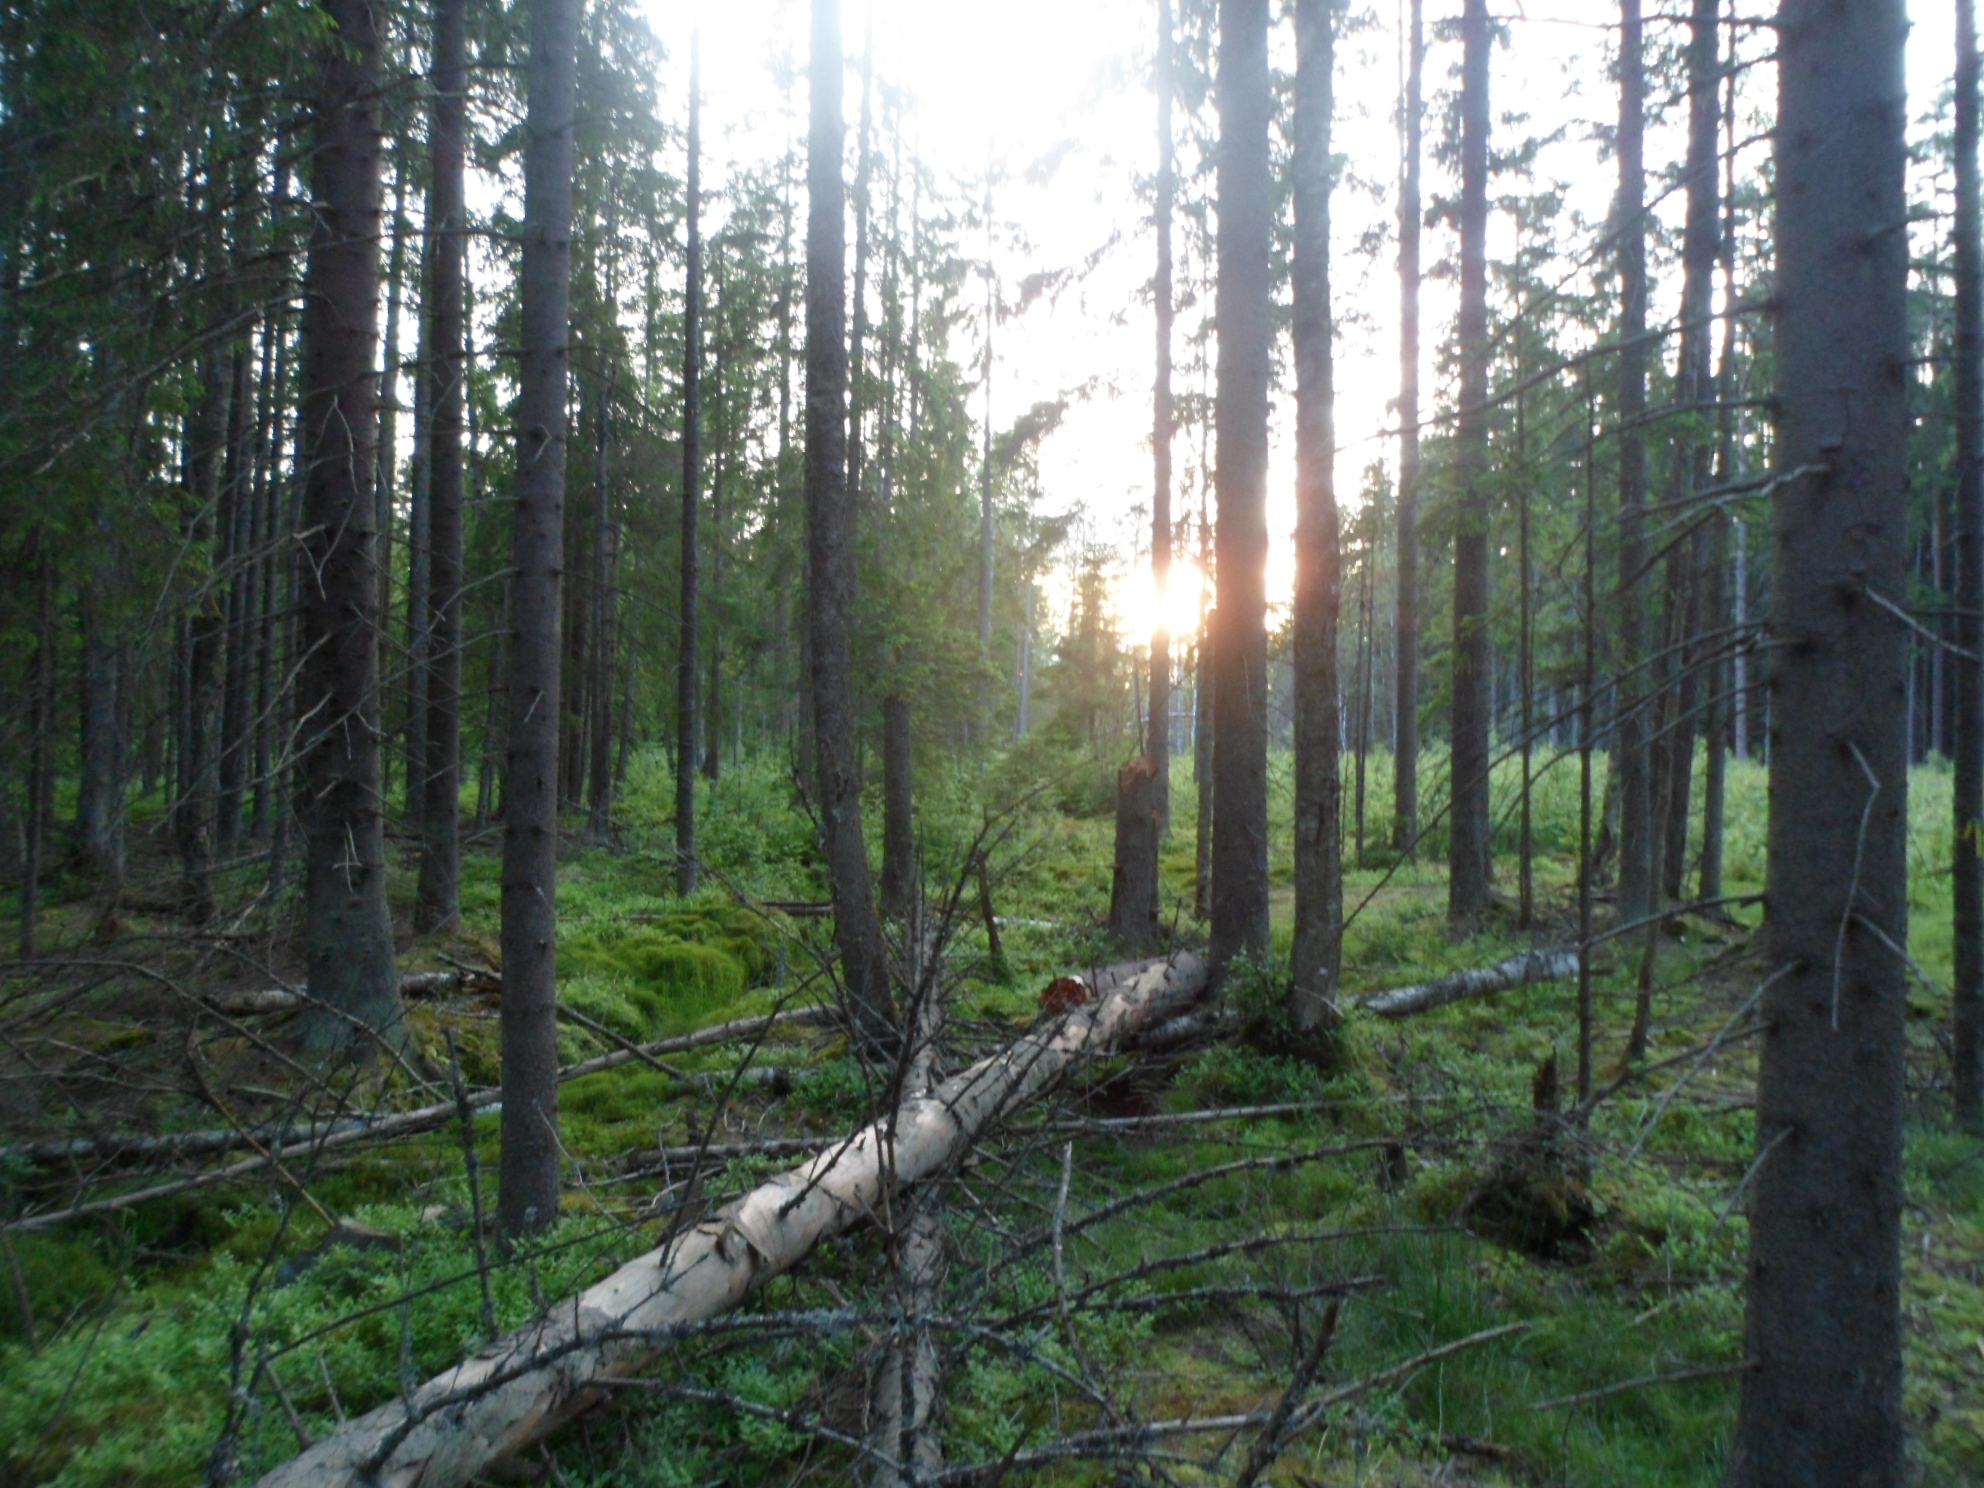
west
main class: Woodland
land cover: Spruce dominated coniferous woodland
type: boreal forest
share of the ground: 50 - 75 %
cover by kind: coniferous forest trees 55 %, shrubs 15 %, lichens and mosses 15 %, broadleaved forest trees 10 %, herbaceous plants 5 %
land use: Forestry
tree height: > 5 m
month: June
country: SE
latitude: 57.0479
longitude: 15.3879
